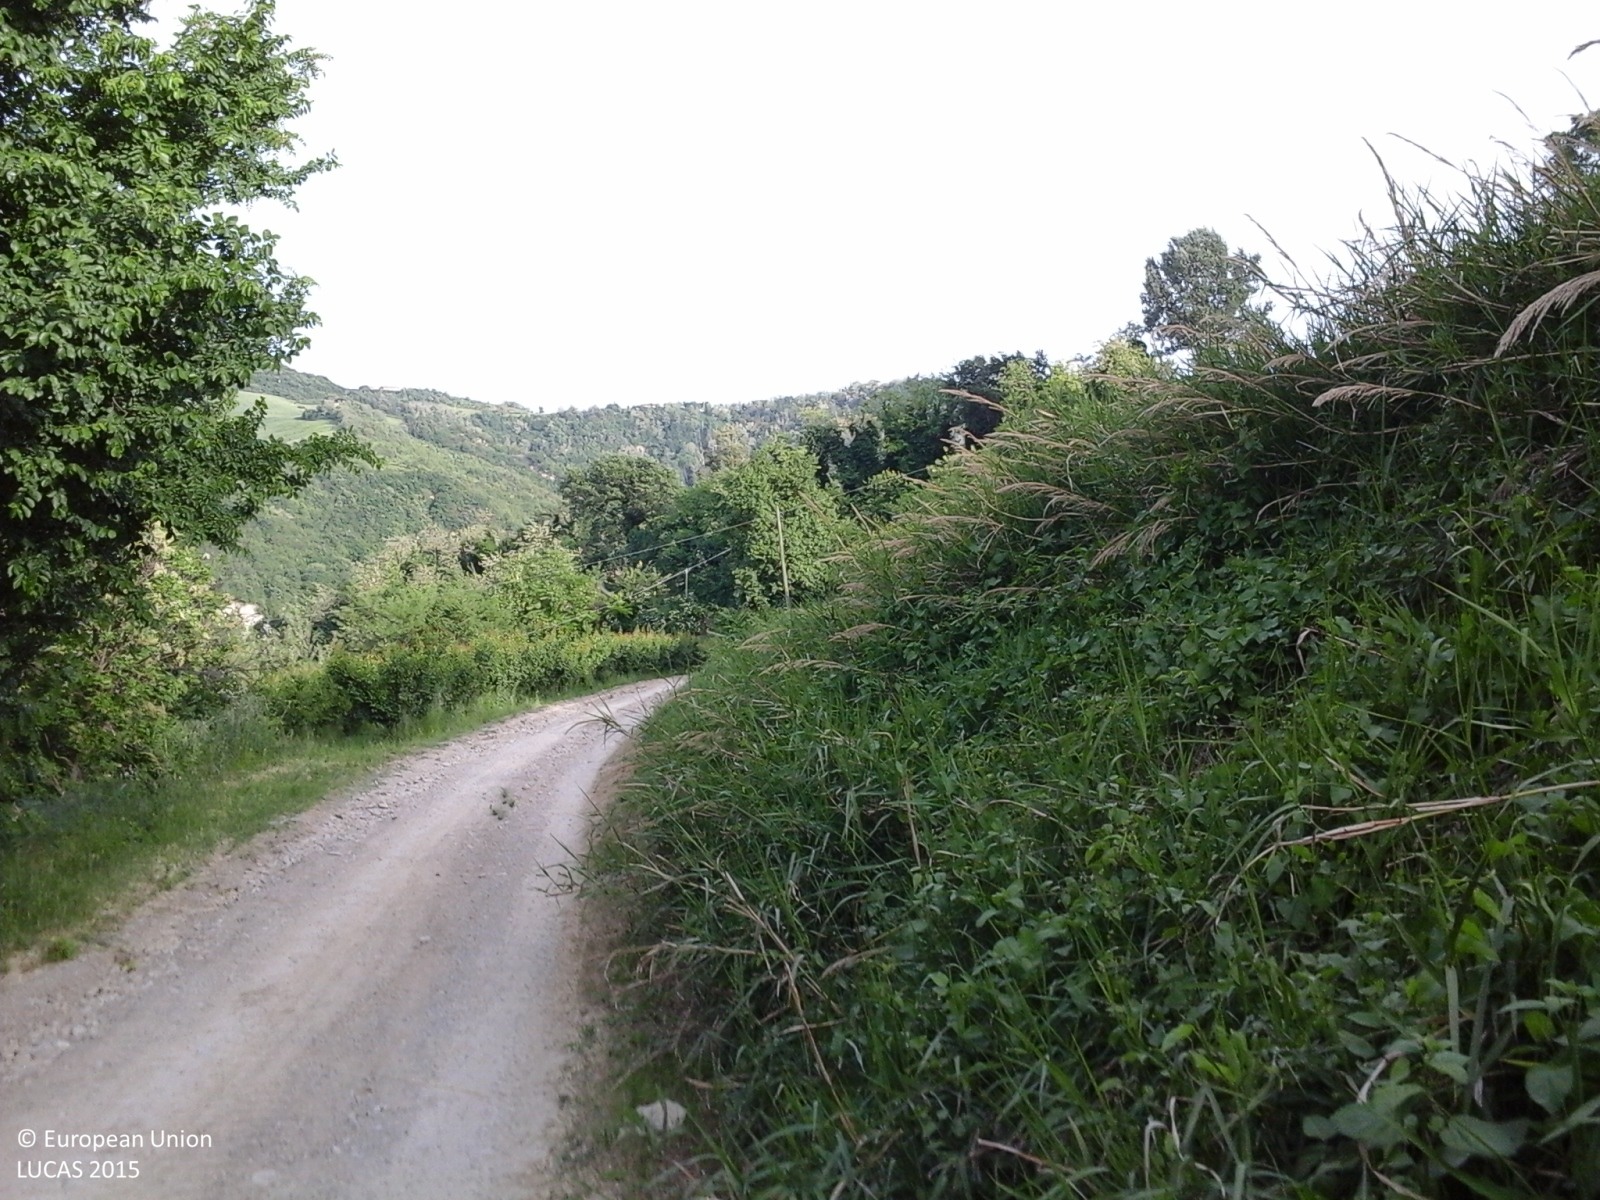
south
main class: Grassland
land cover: Spontaneously vegetated surfaces
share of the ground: > 75 %
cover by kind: herbaceous plants 100 %
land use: Semi-natural and natural areas not in use
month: May
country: IT
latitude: 44.1165
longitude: 11.9073
